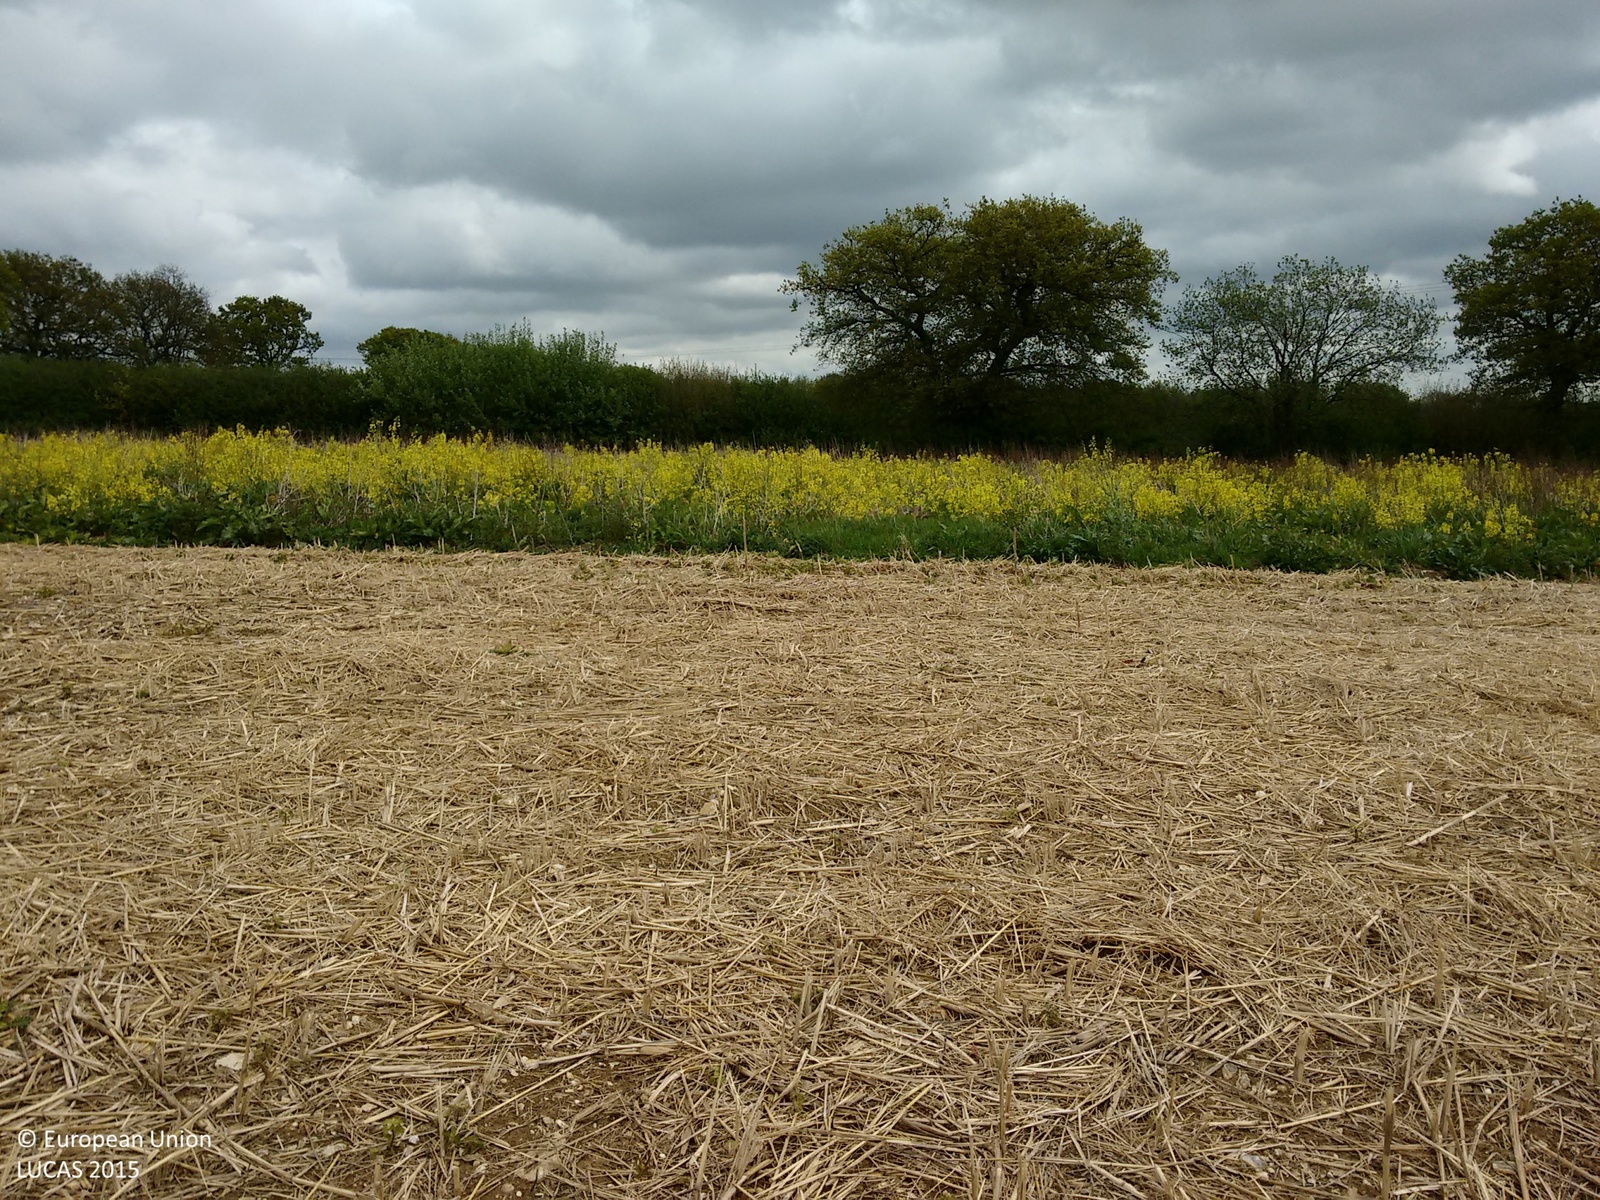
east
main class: Grassland
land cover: Spontaneously vegetated surfaces
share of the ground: < 10 %
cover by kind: unconsolidated bare surface 80 %, herbaceous plants 20 %
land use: Fallow land
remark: Harvested field
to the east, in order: Spontaneously vegetated surfaces; Rape and turnip rape; Spontaneously vegetated surfaces; Single bushes/trees; Abandoned hedges; Ditches and canals; Grassland without tree/shrub cover; Common wheat; Electric lines; Common wheat
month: May
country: GB
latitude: 51.8758
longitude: -0.4820
